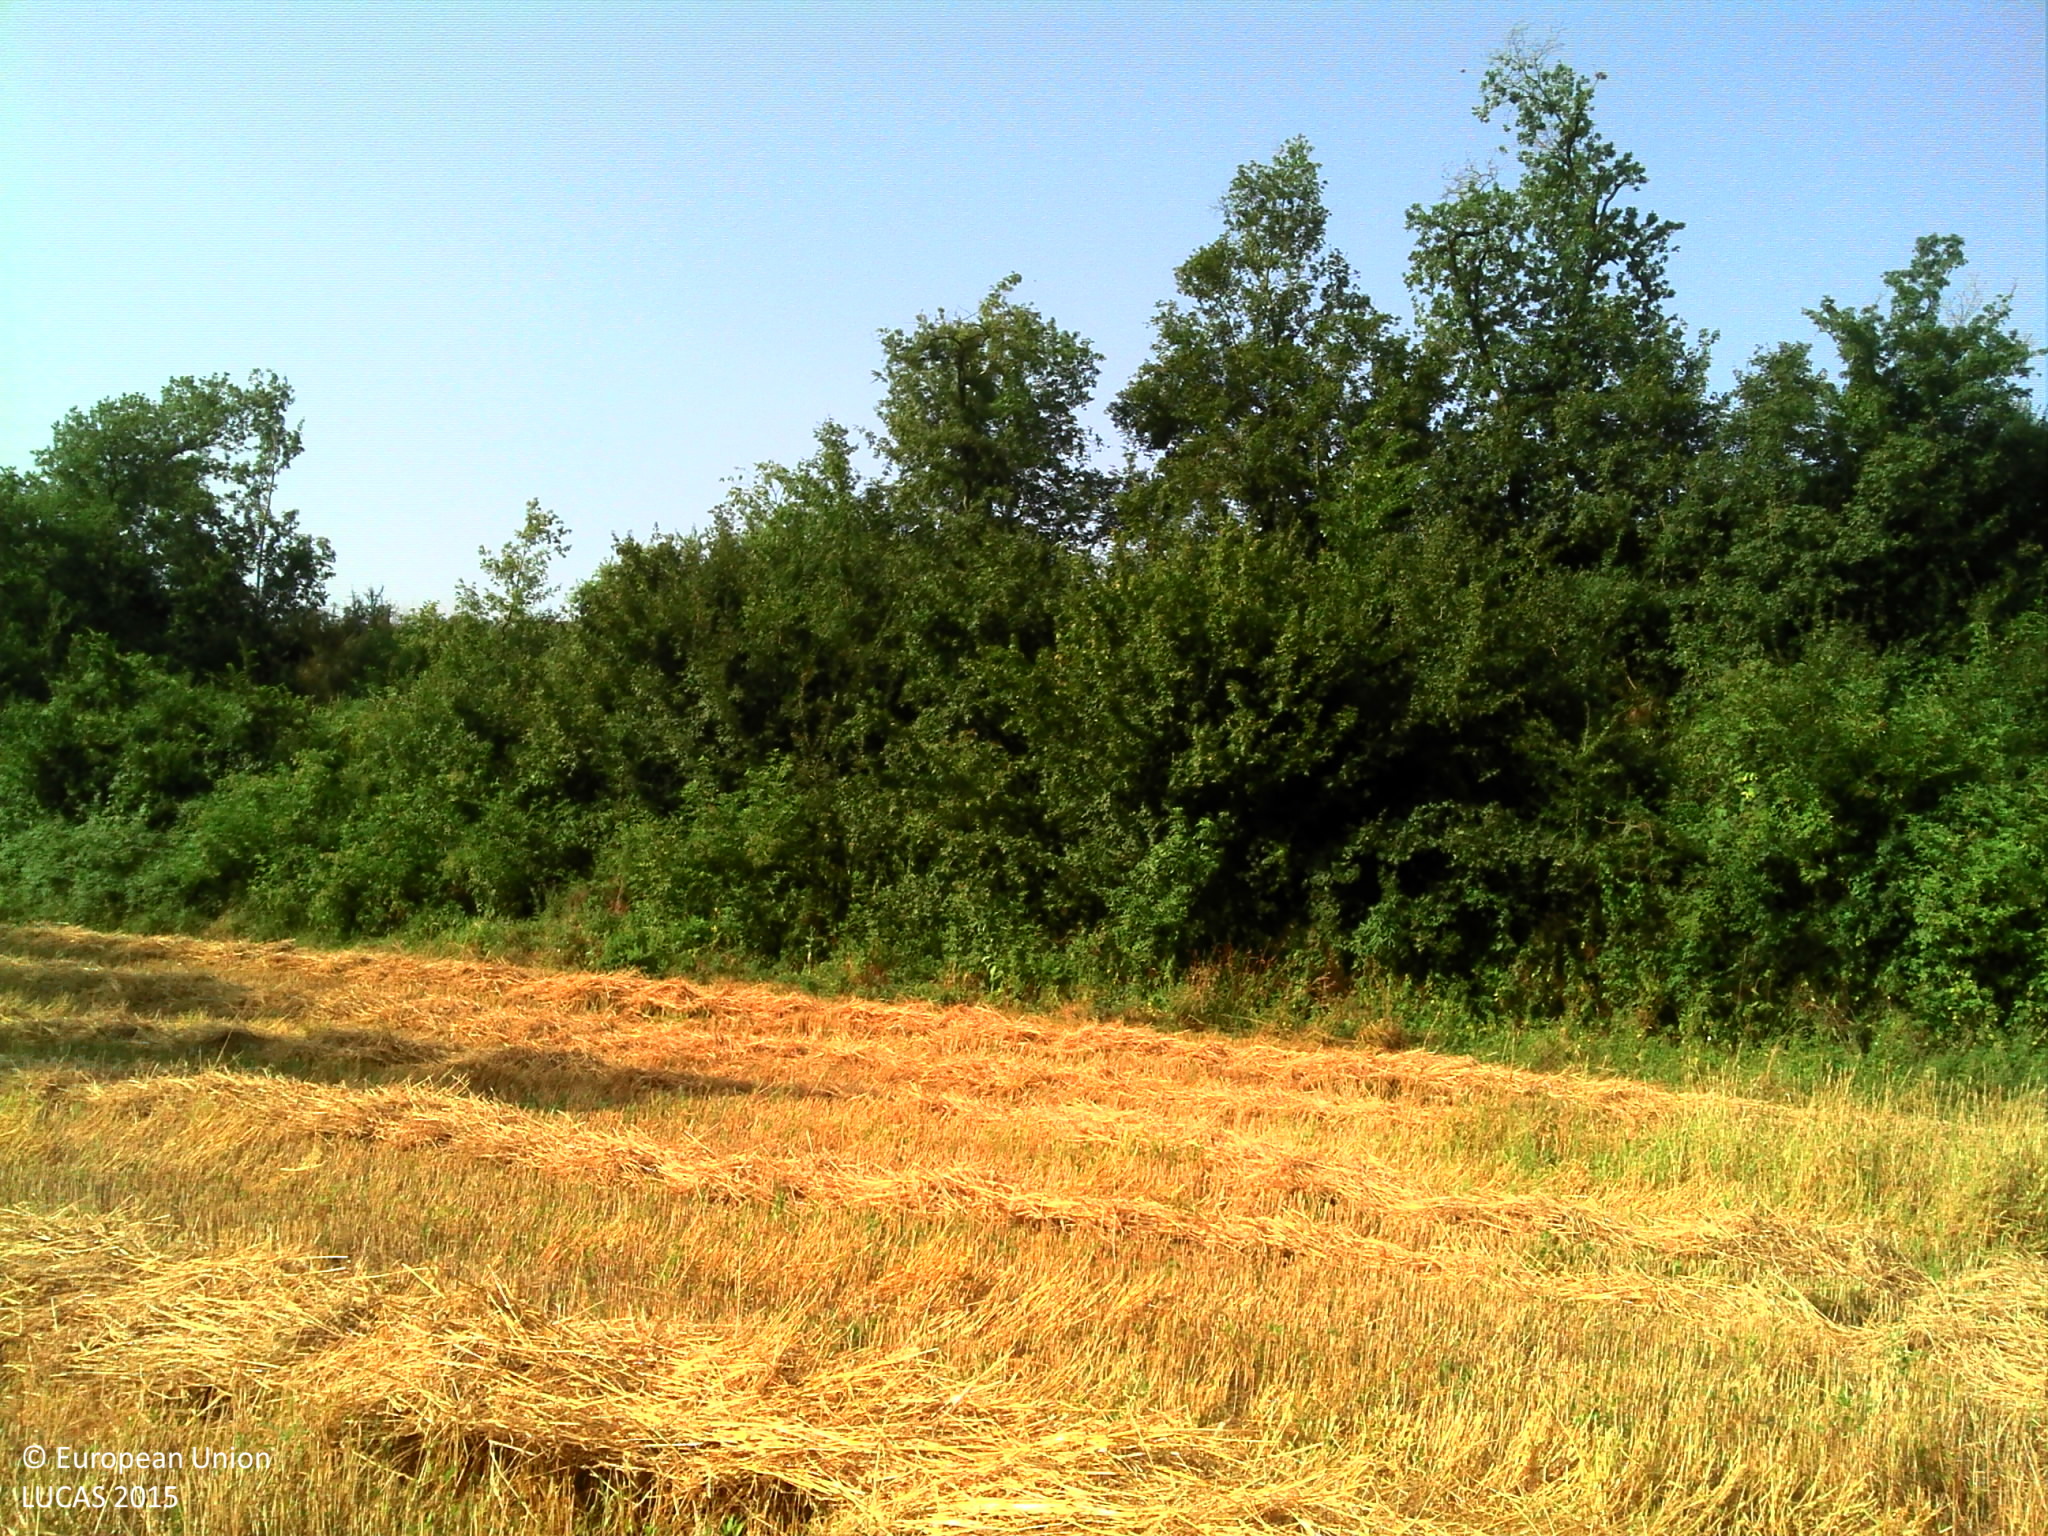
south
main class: Cropland
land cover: Durum wheat
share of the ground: > 75 %
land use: Agriculture (excluding fallow land and kitchen gardens)
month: July
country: FR
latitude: 43.2490
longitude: 1.3951
